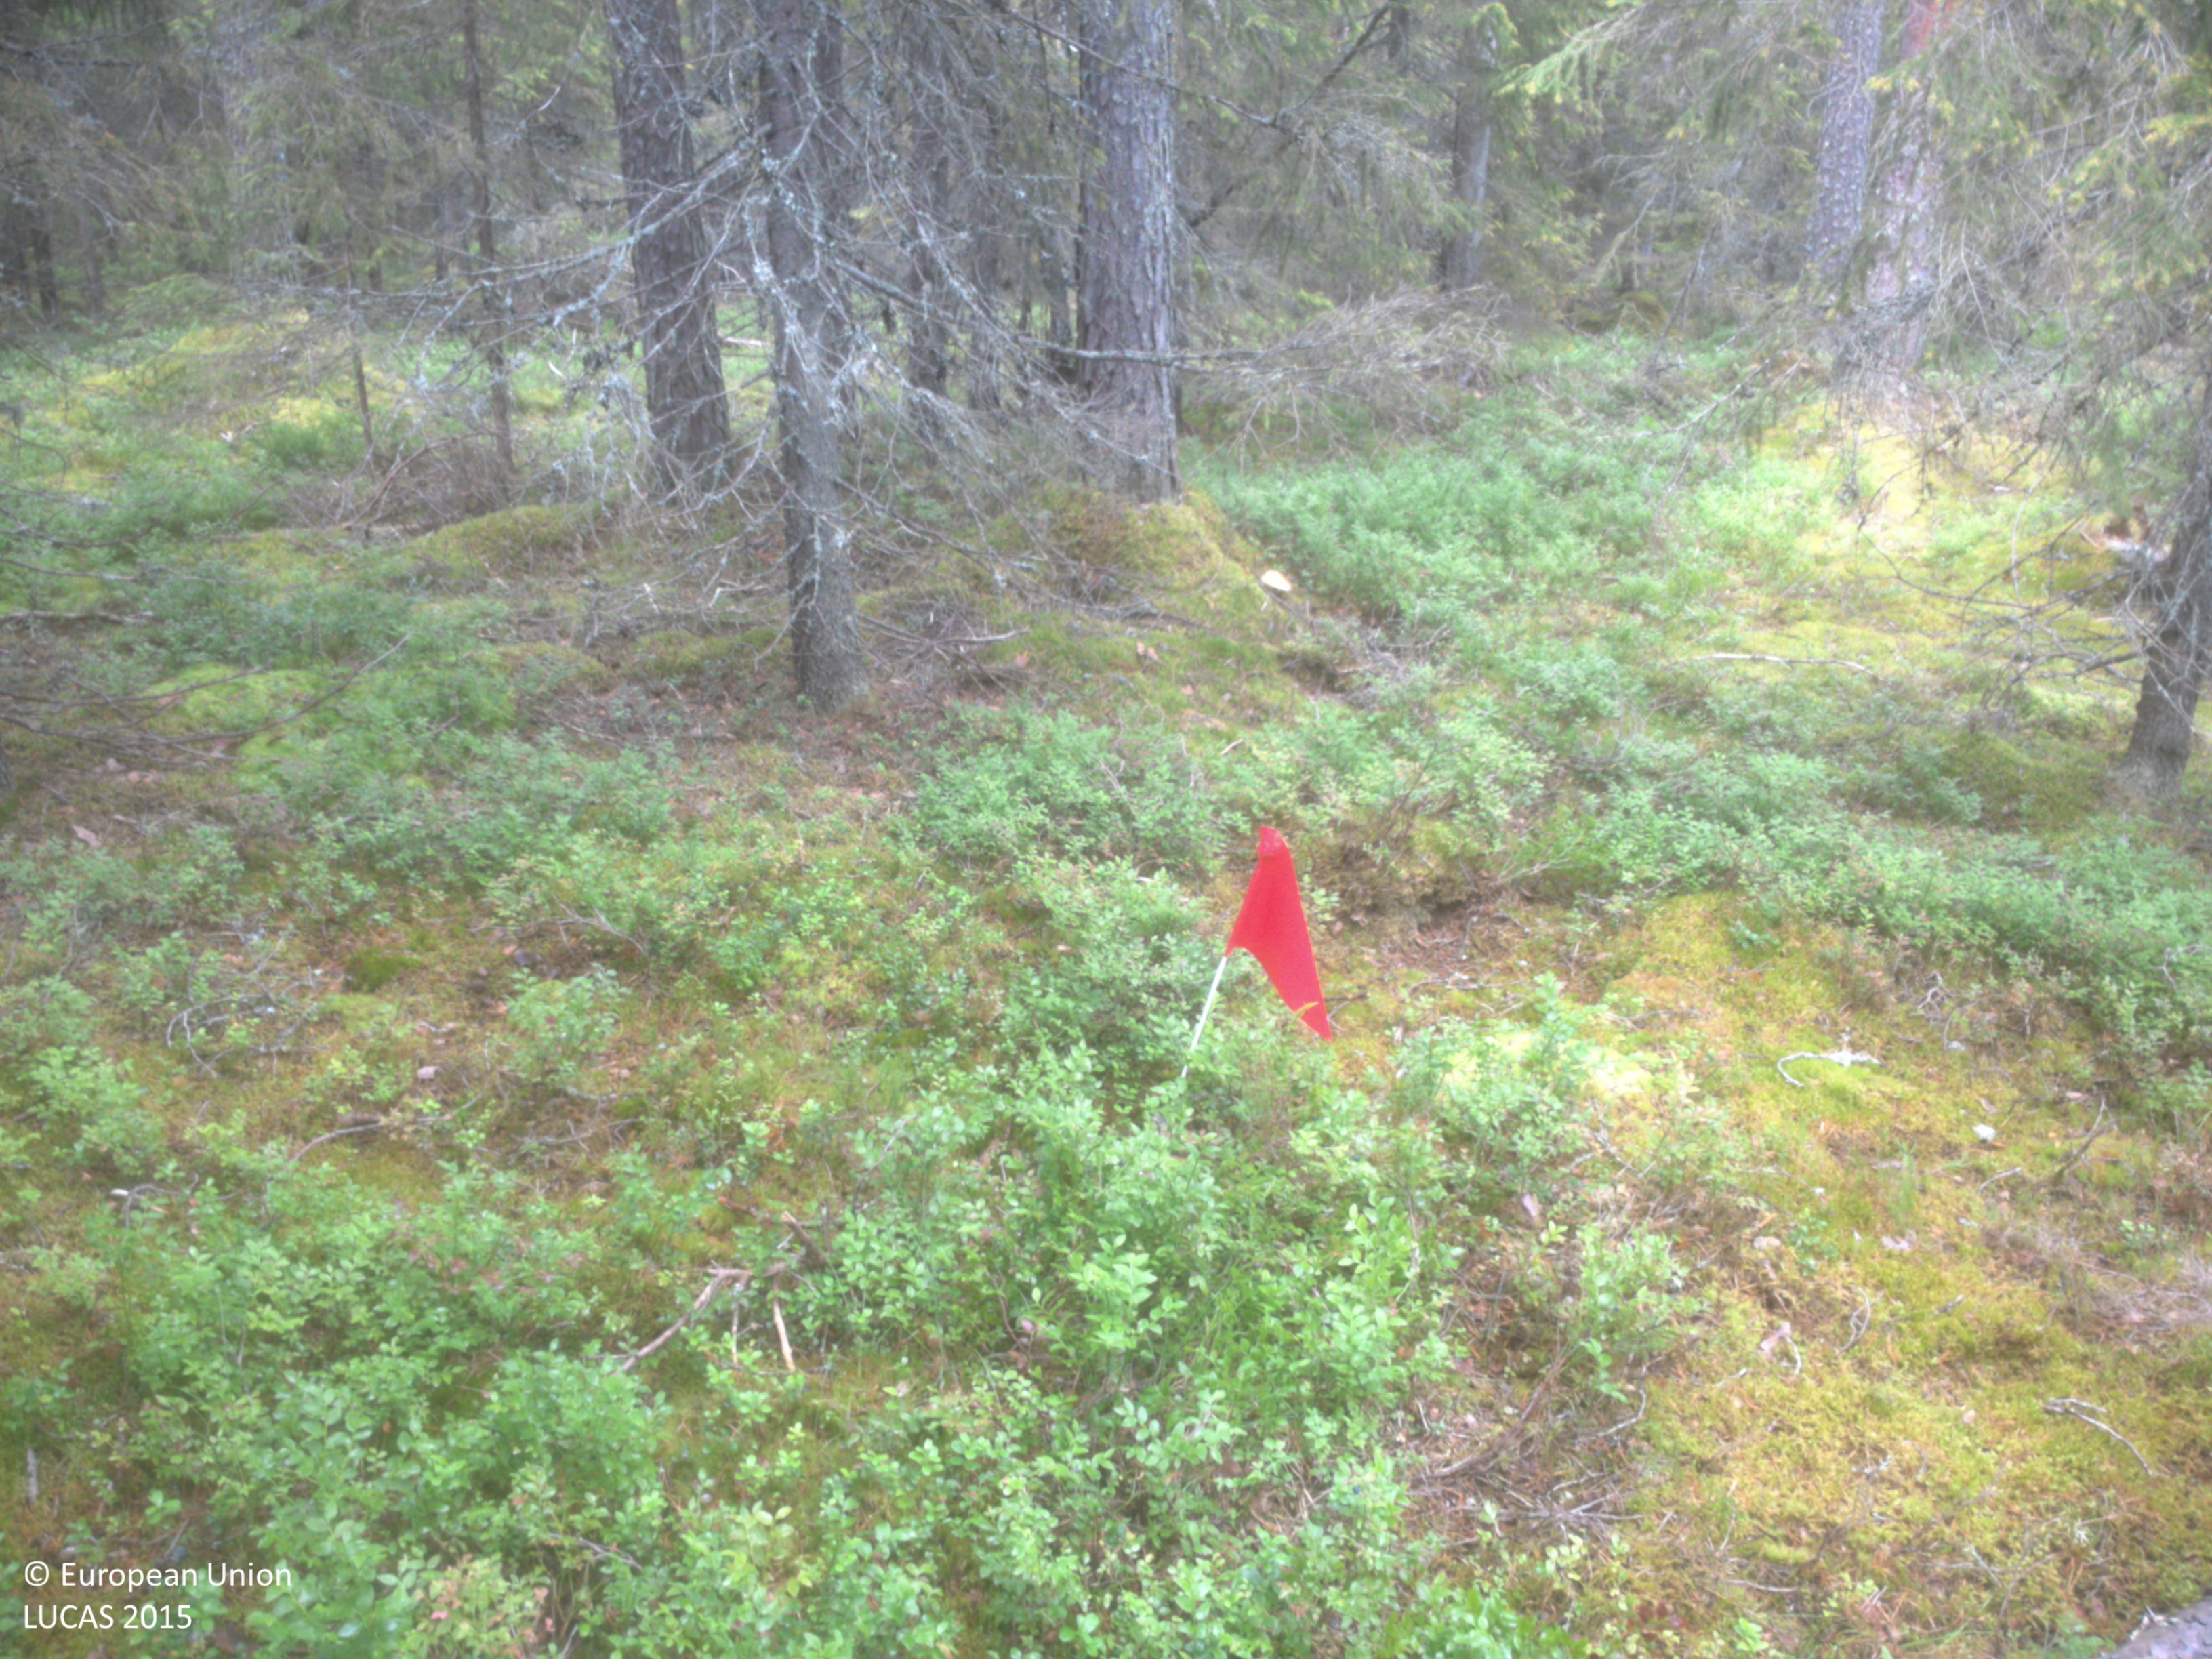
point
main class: Woodland
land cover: Other coniferous woodland
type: boreal forest
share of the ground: 50 - 75 %
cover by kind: coniferous forest trees 70 %, shrubs 20 %, lichens and mosses 10 %
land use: Forestry
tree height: > 5 m
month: August
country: SE
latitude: 63.7428
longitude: 19.8873
